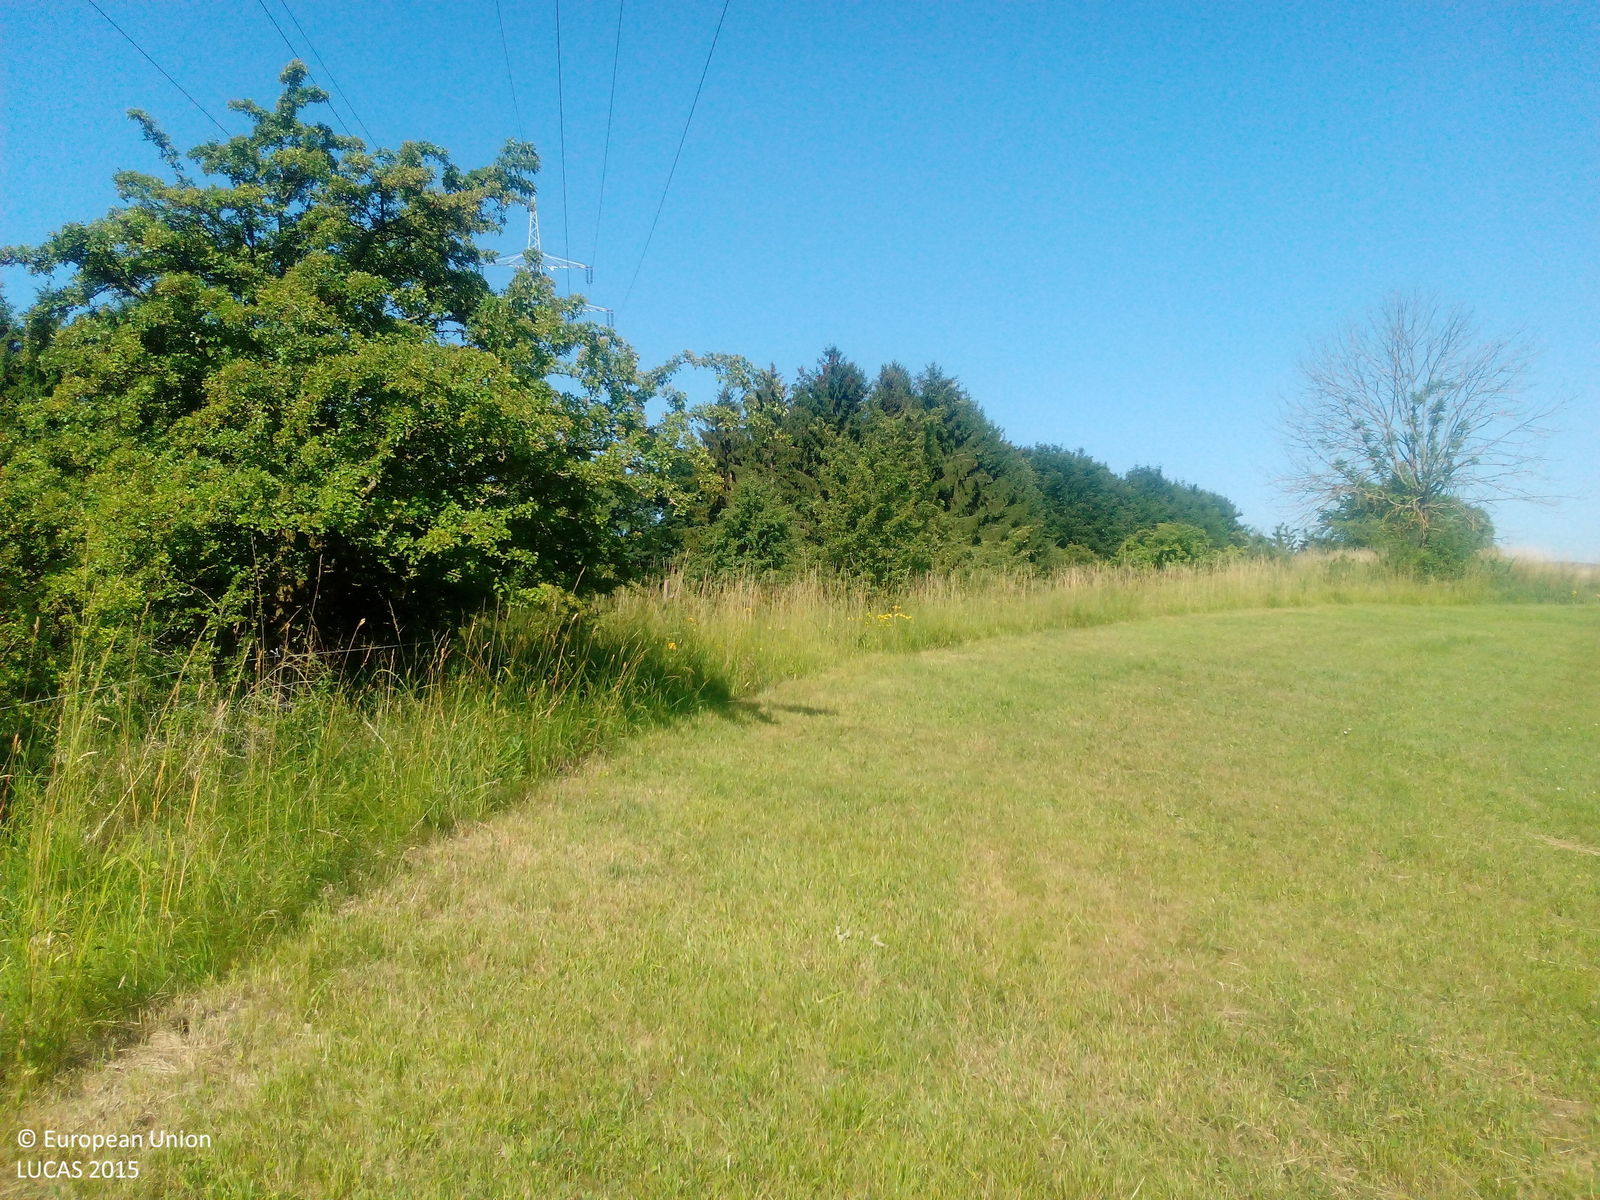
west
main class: Artificial land
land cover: Other artificial areas
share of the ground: > 75 %
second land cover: Grassland with sparse tree/shrub cover
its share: > 75 %
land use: Electricity, gas and thermal power distribution
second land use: Agriculture (excluding fallow land and kitchen gardens)
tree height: > 5 m
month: July
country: DE
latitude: 51.6944
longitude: 9.9566
